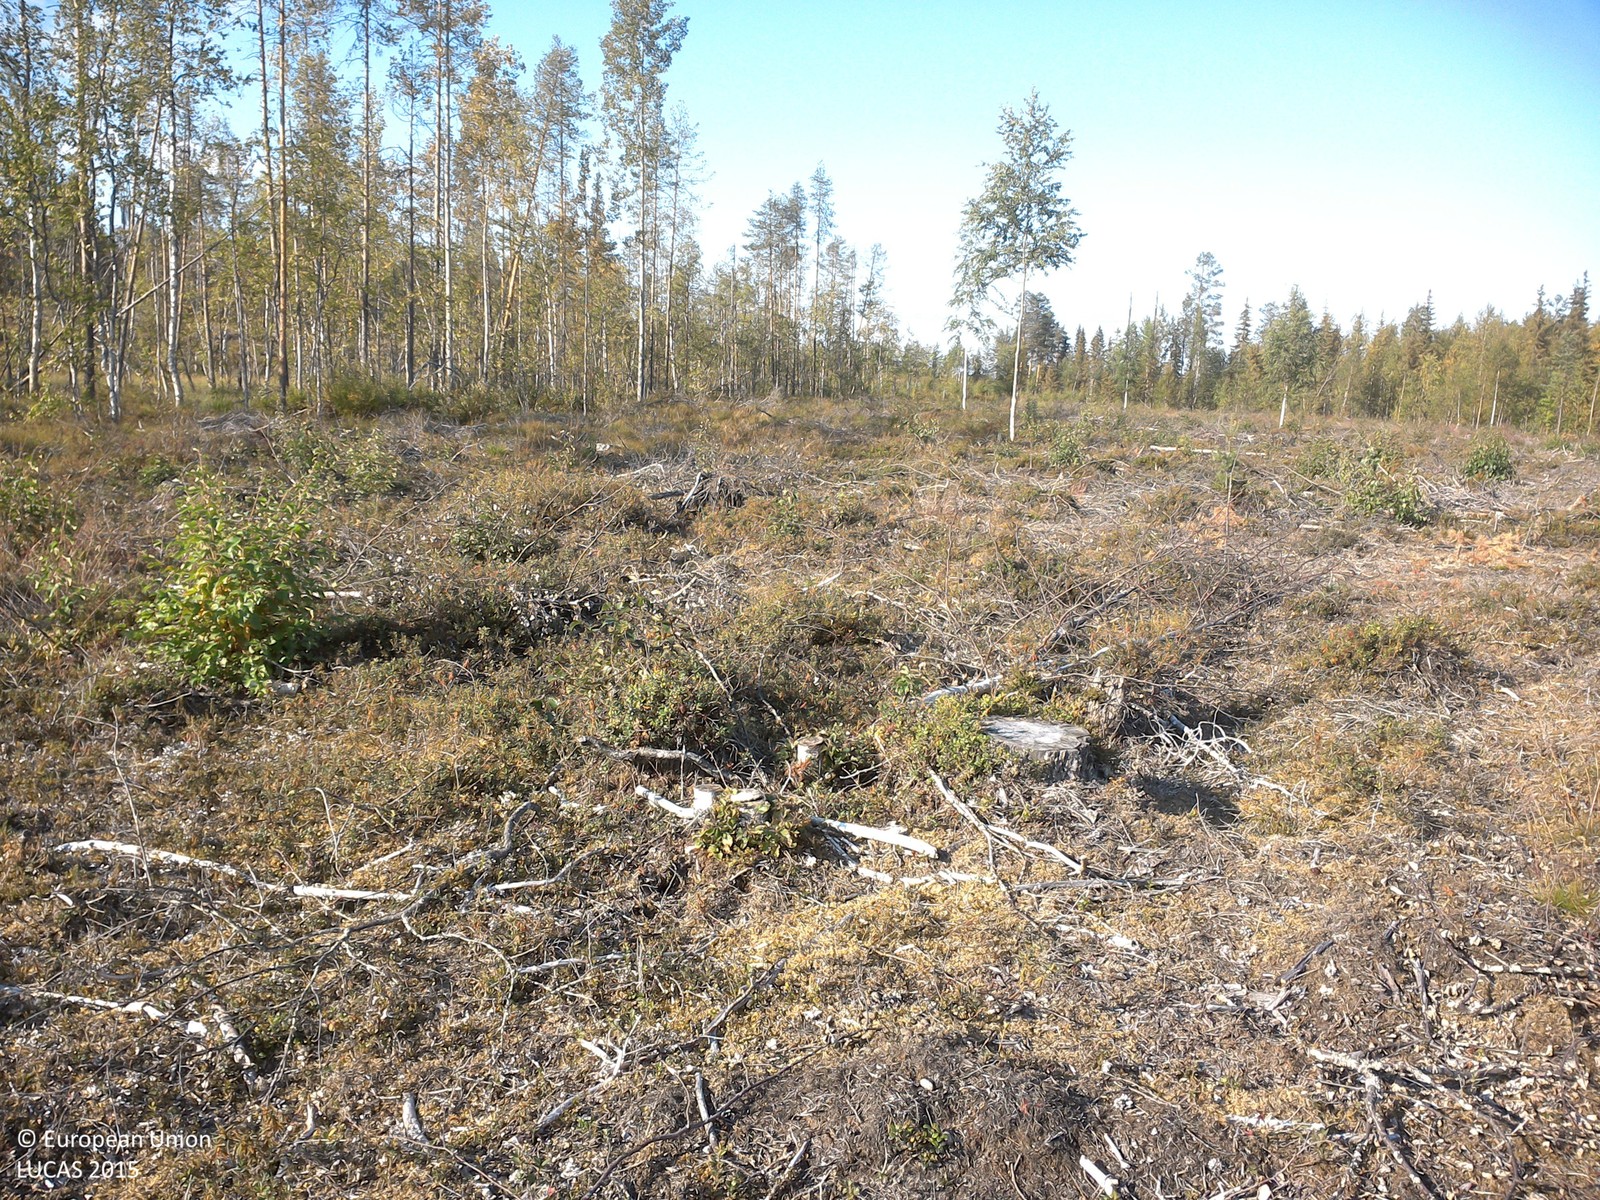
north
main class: Shrubland
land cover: Shrubland with sparse tree cover
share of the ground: 25 - 50 %
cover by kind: lichens and mosses 50 %, shrubs 30 %, unconsolidated bare surface 15 %, broadleaved forest trees 5 %
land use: Forestry
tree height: < 5 m
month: August
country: SE
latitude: 67.1070
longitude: 22.6113
